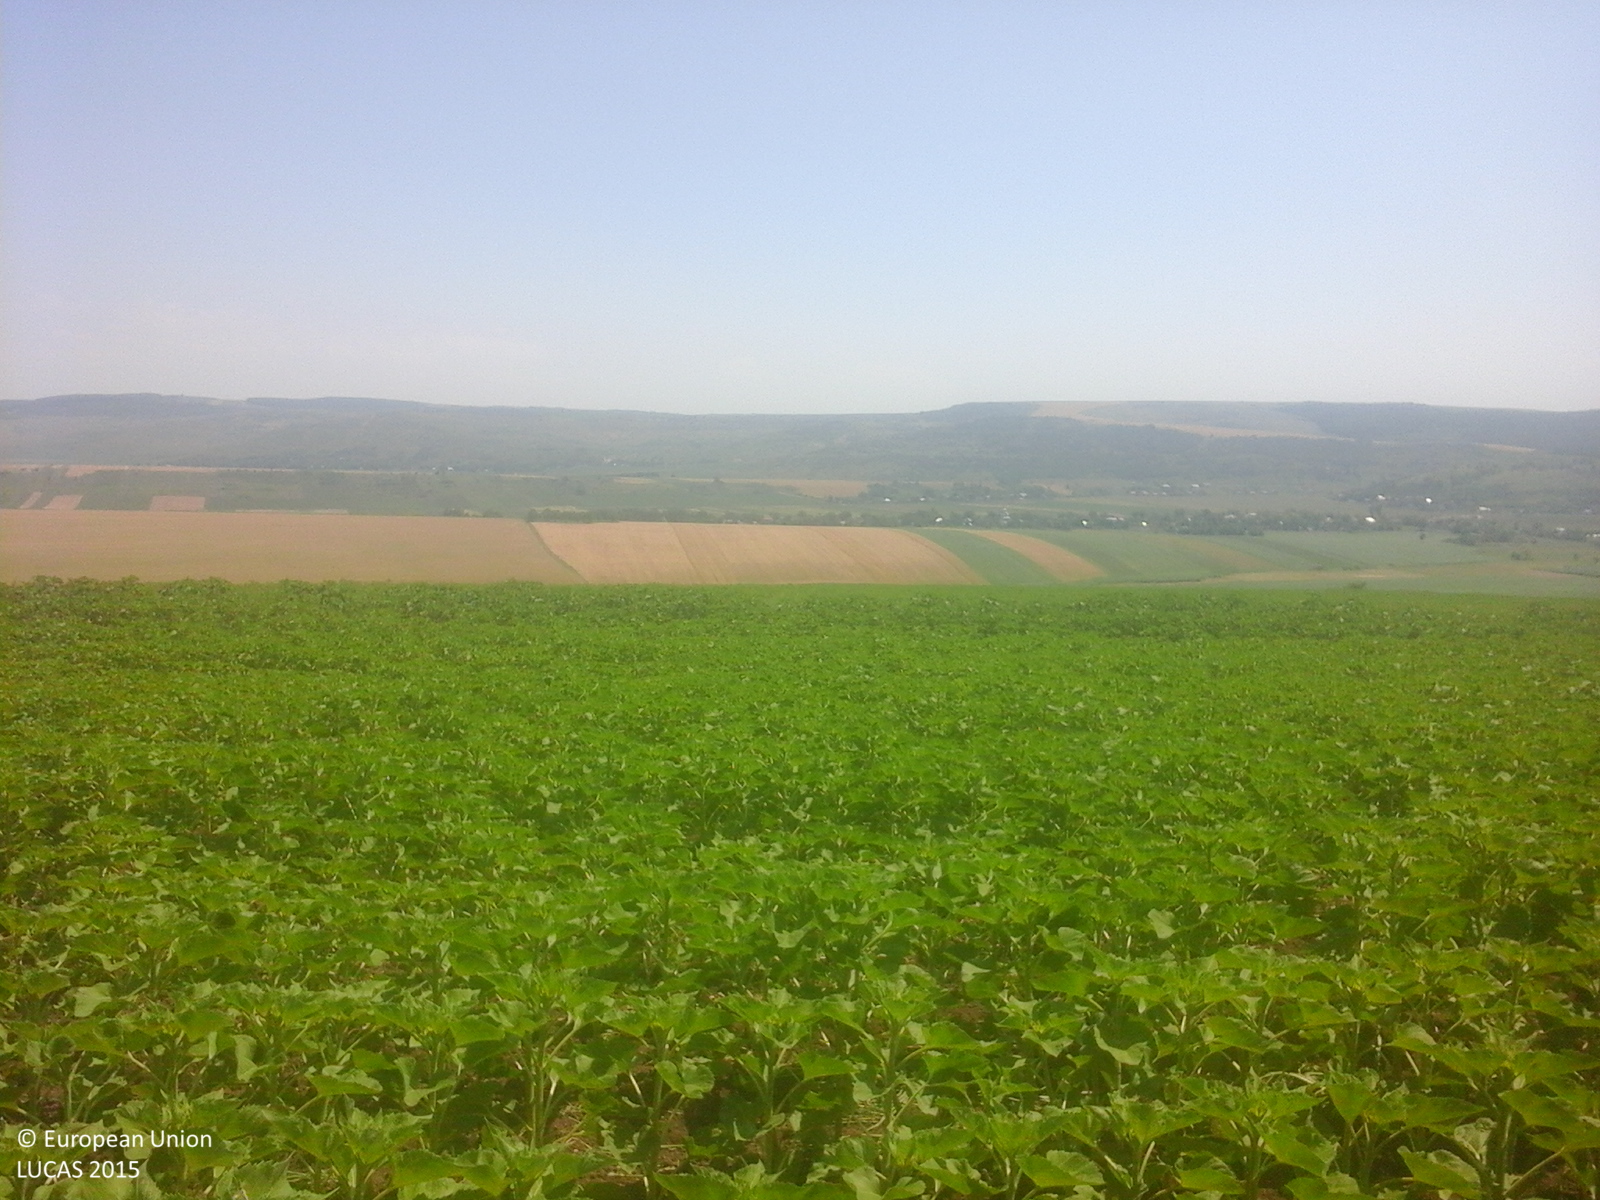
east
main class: Cropland
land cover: Sunflower
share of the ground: > 75 %
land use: Agriculture (excluding fallow land and kitchen gardens)
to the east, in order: Sunflower; Grass margins; Tracks; Grass margins; Sunflower; Grassland without tree/shrub cover
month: June
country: RO
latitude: 46.8391
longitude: 27.5403
